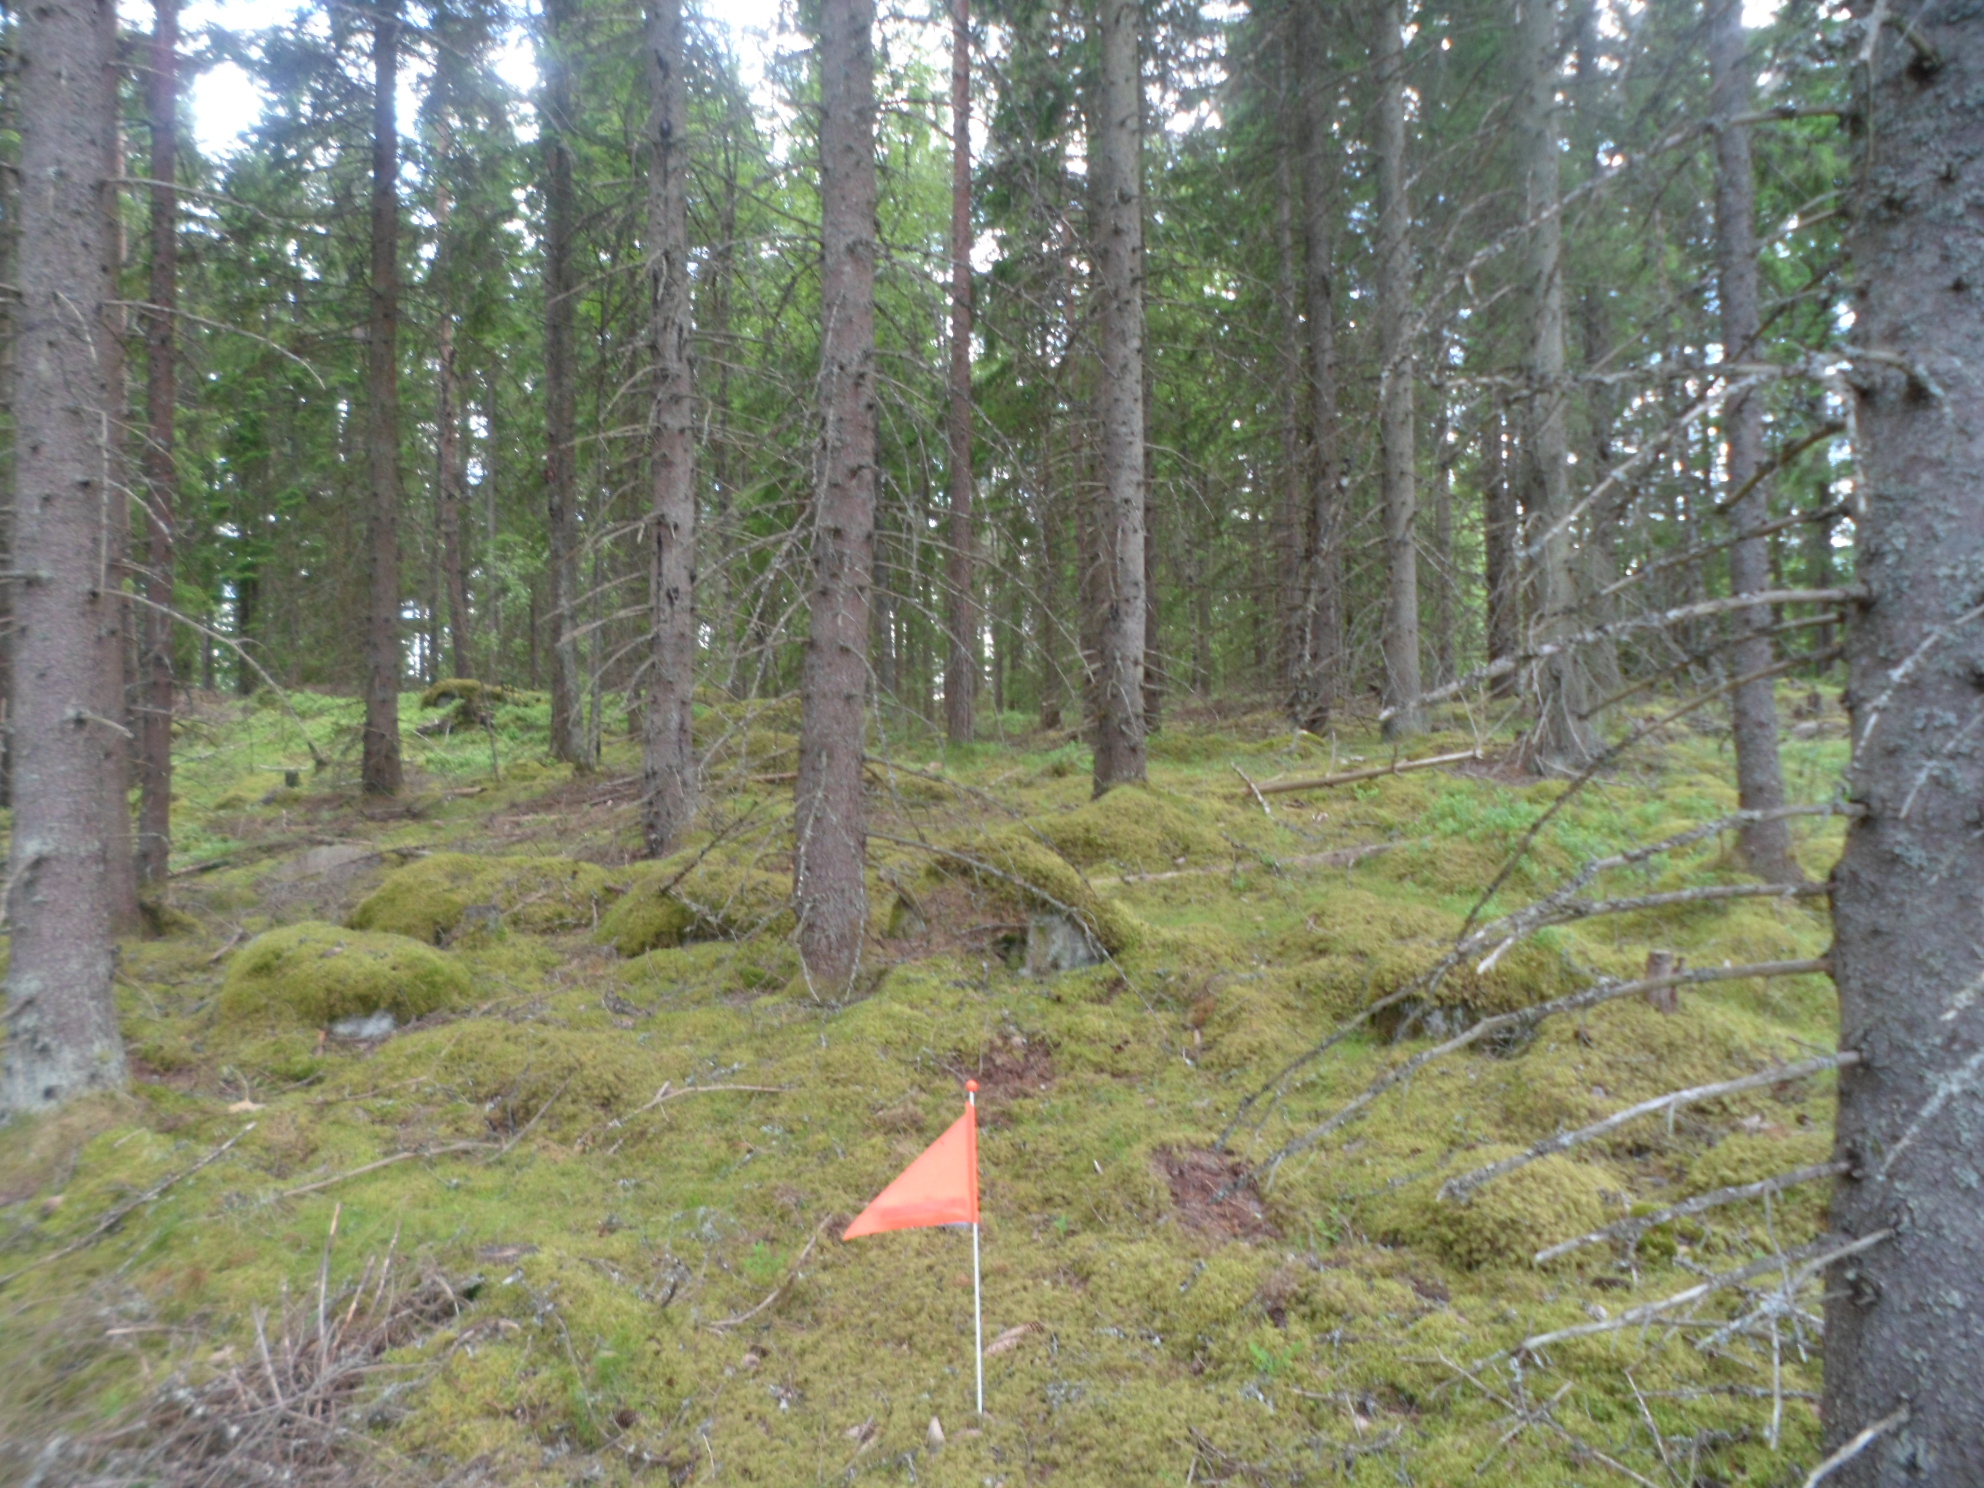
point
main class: Woodland
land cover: Spruce dominated coniferous woodland
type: boreal forest
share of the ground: 50 - 75 %
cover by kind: coniferous forest trees 60 %, shrubs 15 %, lichens and mosses 15 %, broadleaved forest trees 5 %, herbaceous plants 5 %
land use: Forestry
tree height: > 5 m
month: July
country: SE
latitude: 57.5354
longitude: 14.3885
